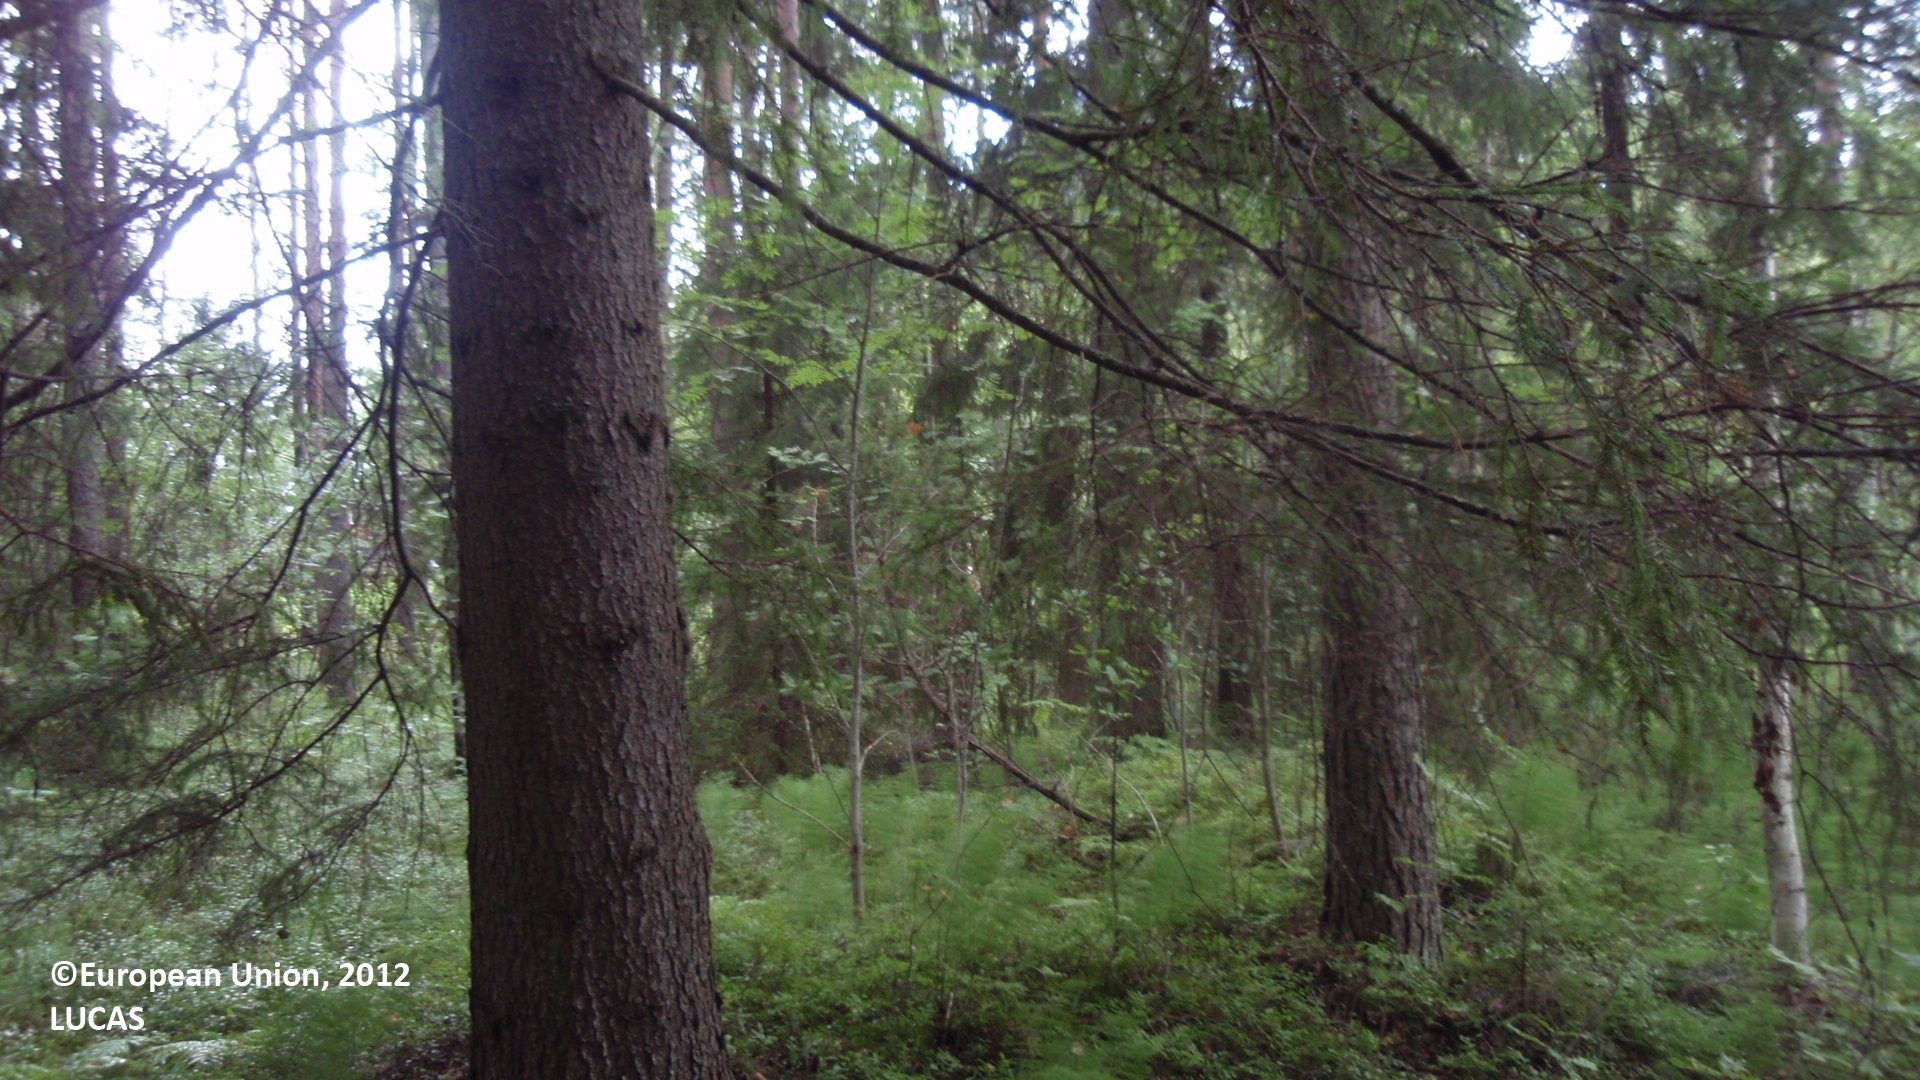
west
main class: Woodland
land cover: Other coniferous woodland
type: boreal forest
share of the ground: 50 - 75 %
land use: Forestry
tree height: > 5 m
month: August
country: FI
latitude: 60.9591
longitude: 26.9140
